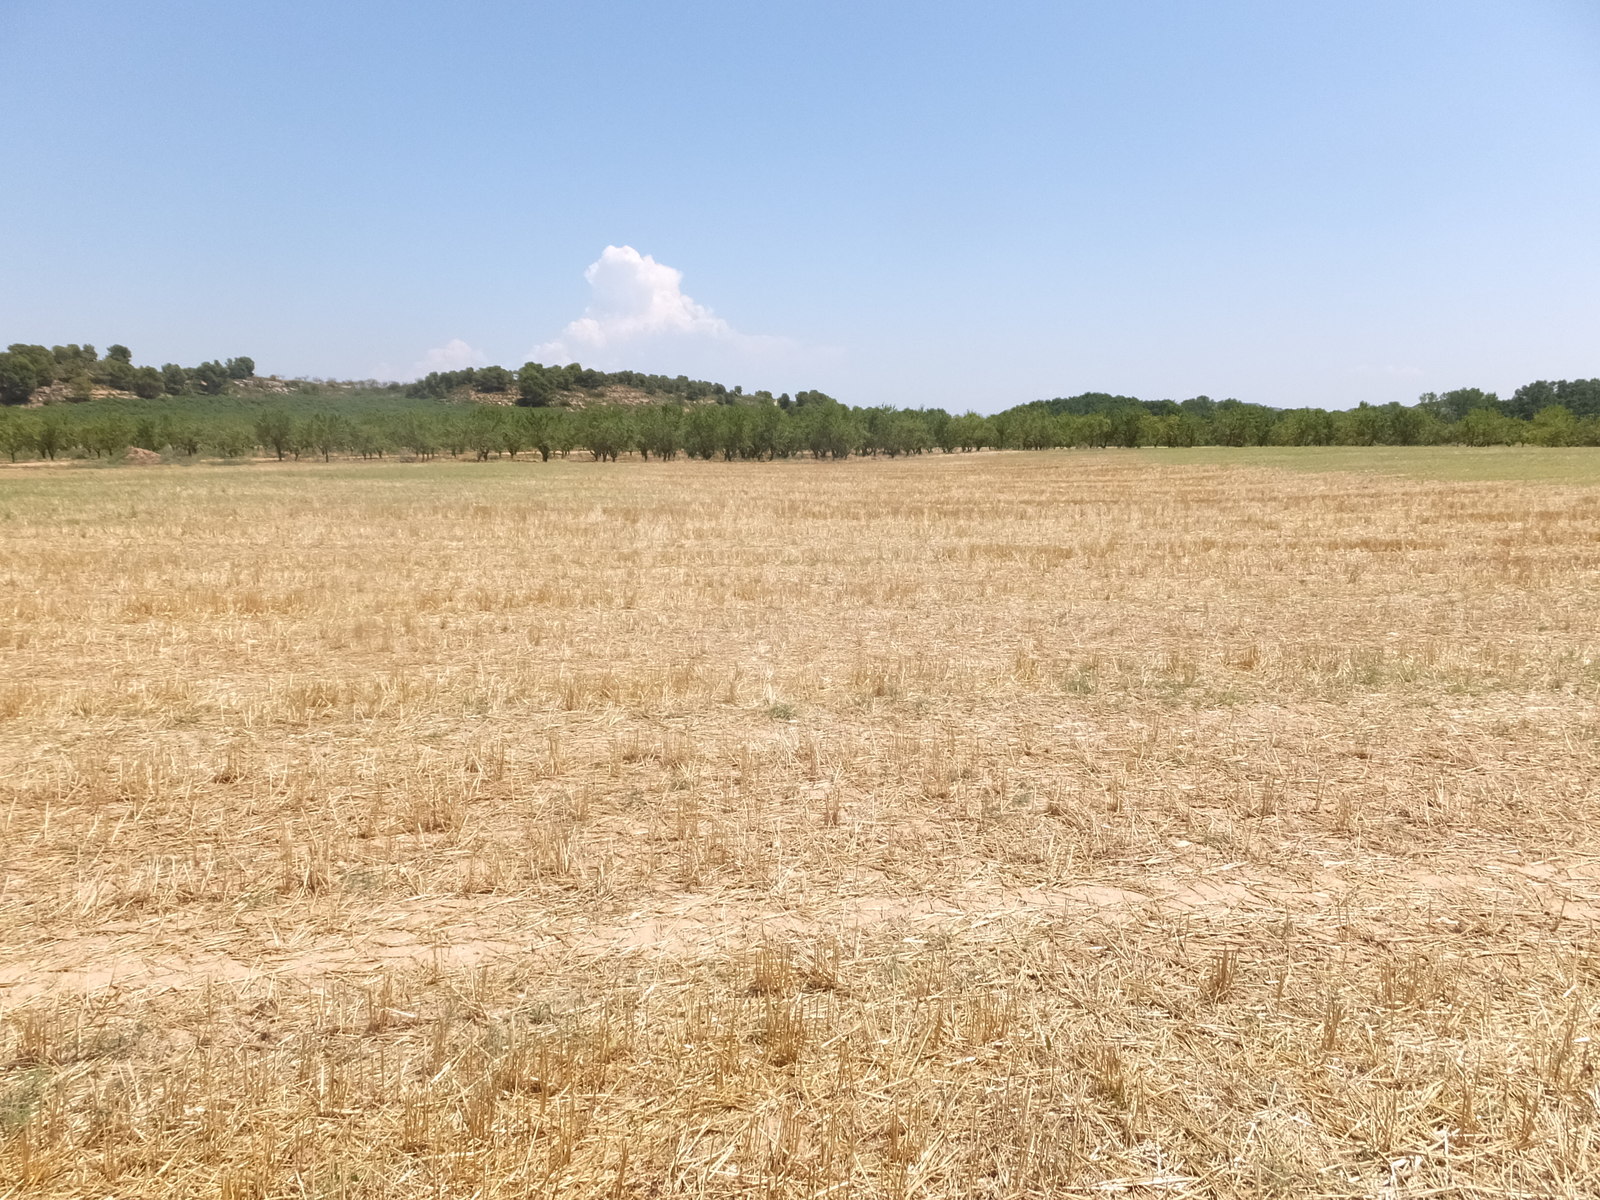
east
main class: Cropland
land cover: Barley
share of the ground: < 10 %
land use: Agriculture (excluding fallow land and kitchen gardens)
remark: Harvested field
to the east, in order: Barley; Grass margins; Tracks; Grass margins; Nuts trees; Tracks; Shruby margins; Paved roads, cycling and walking lanes; Artificial constructions; Tracks; Olive groves
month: July
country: ES
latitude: 41.1706
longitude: 0.1317
